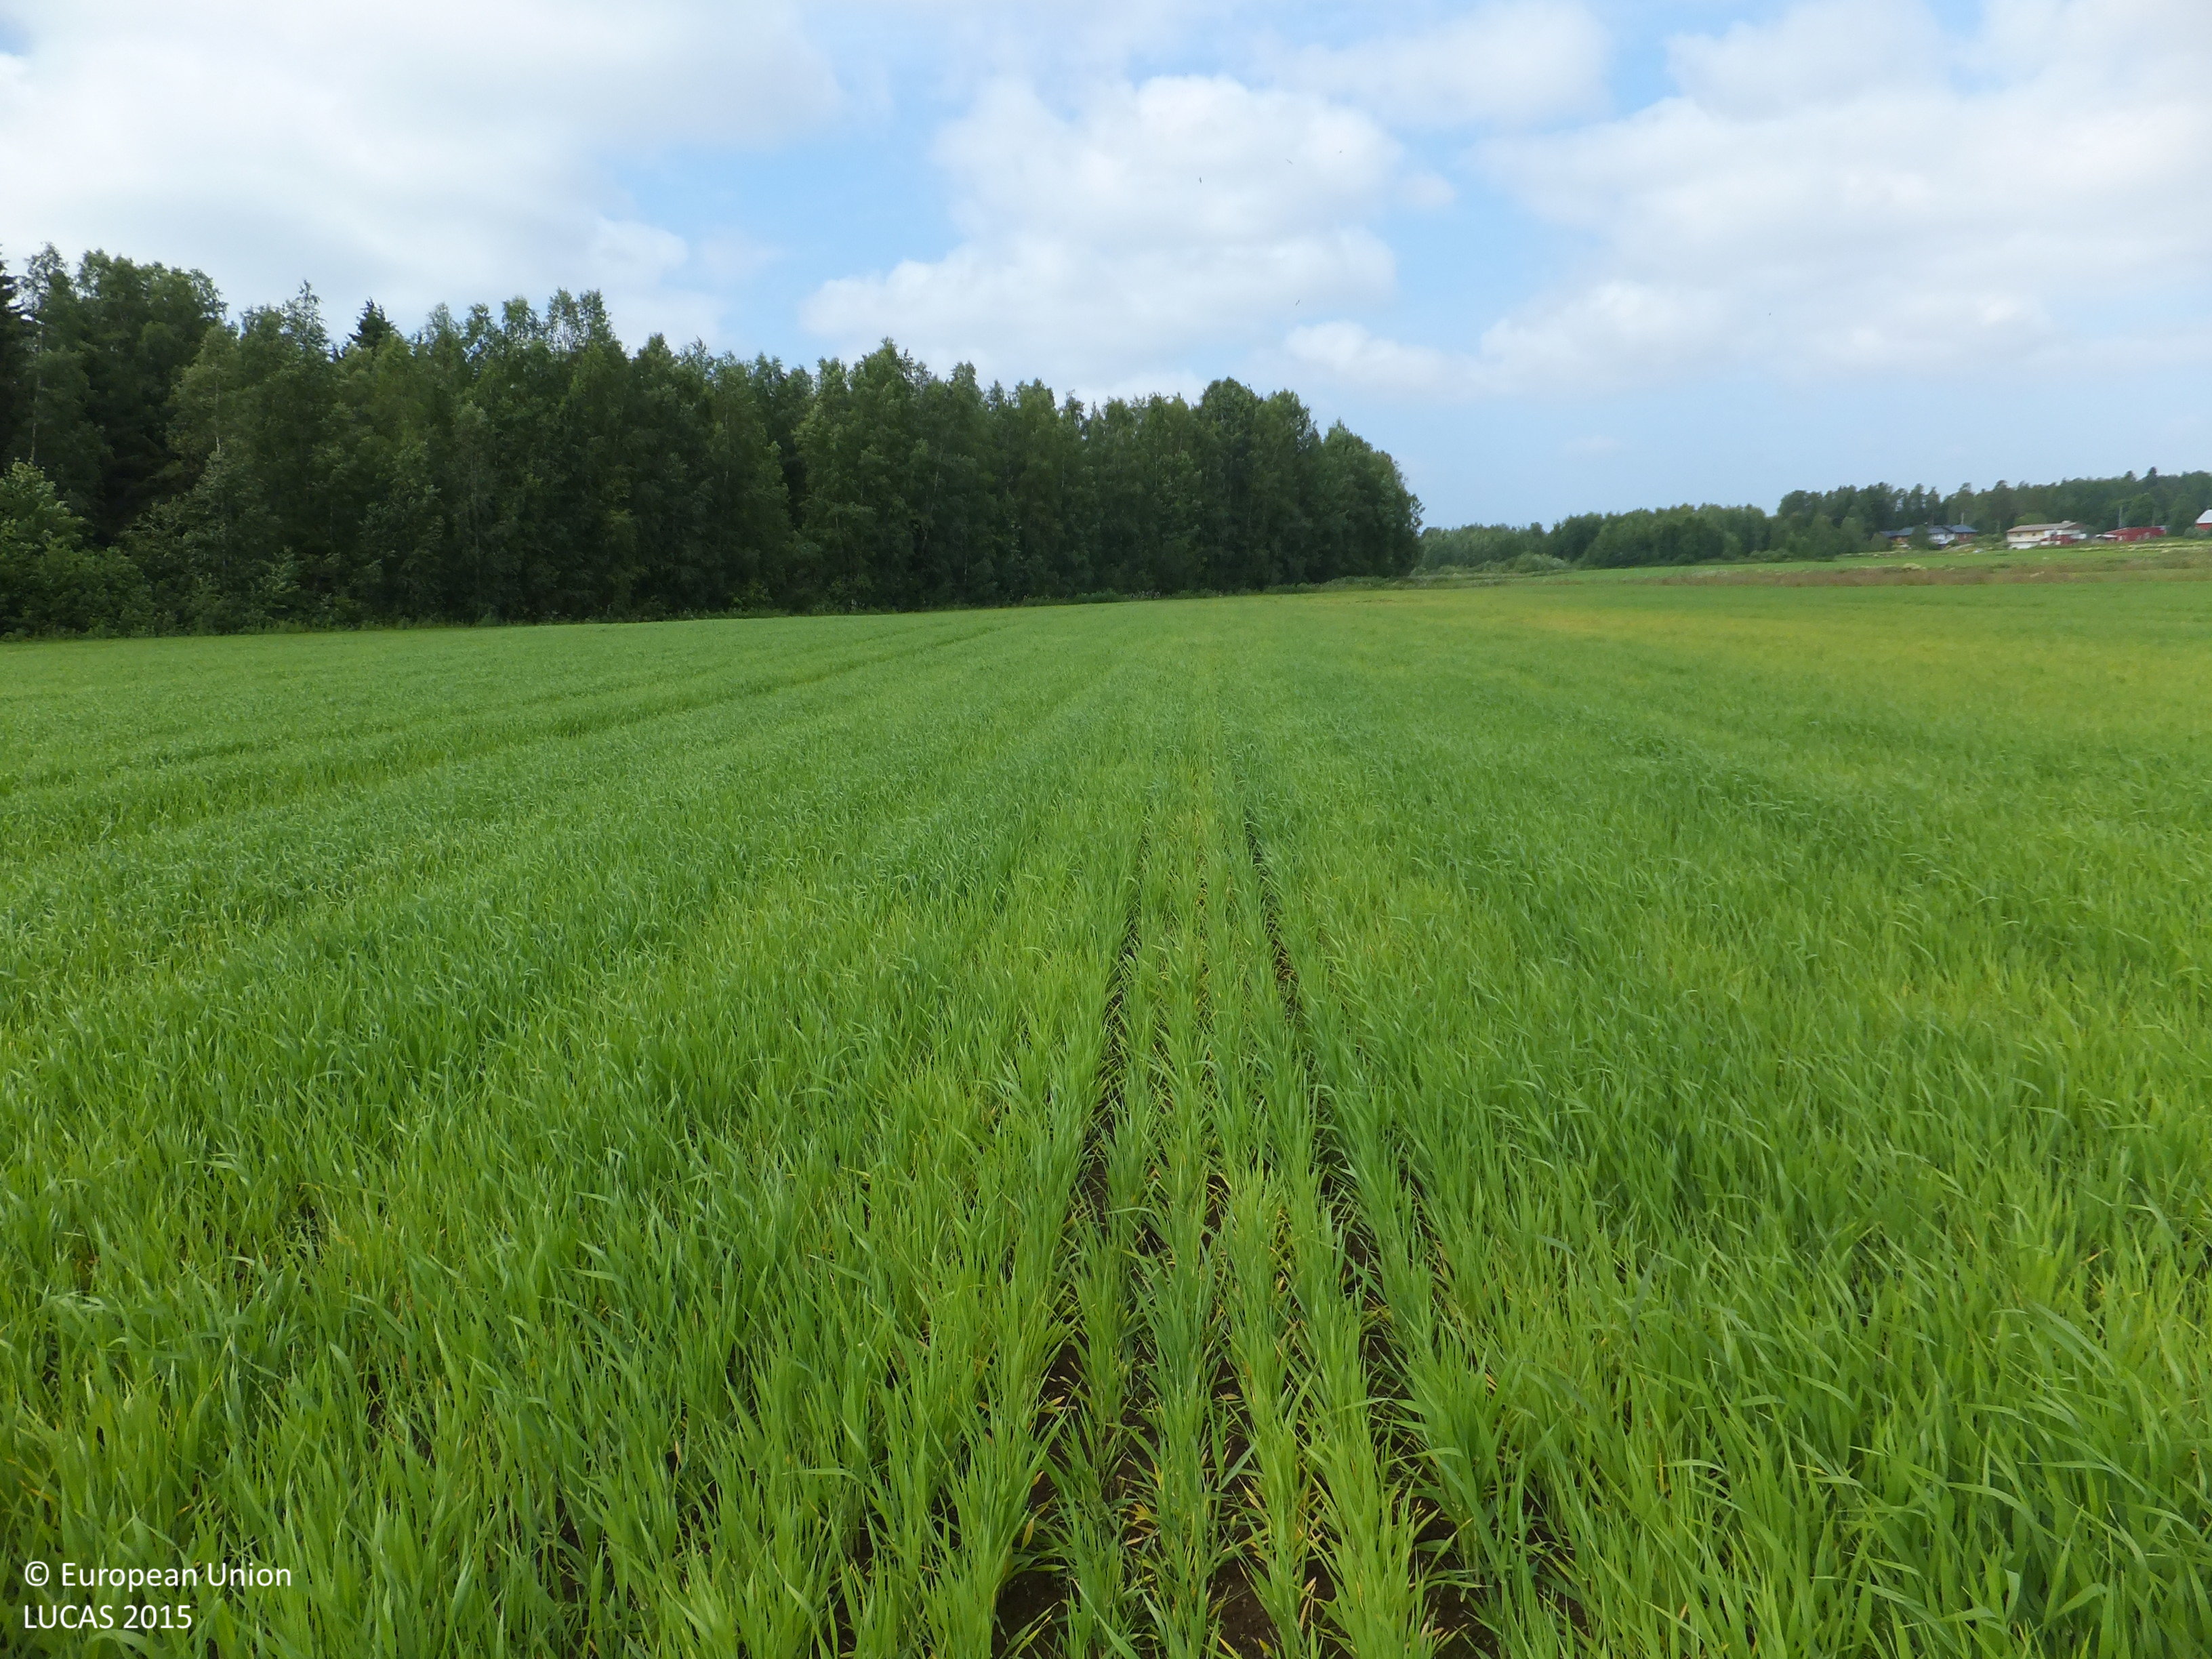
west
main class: Cropland
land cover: Barley
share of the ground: > 75 %
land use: Agriculture (excluding fallow land and kitchen gardens)
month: July
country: FI
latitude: 63.5771
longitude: 22.8823
